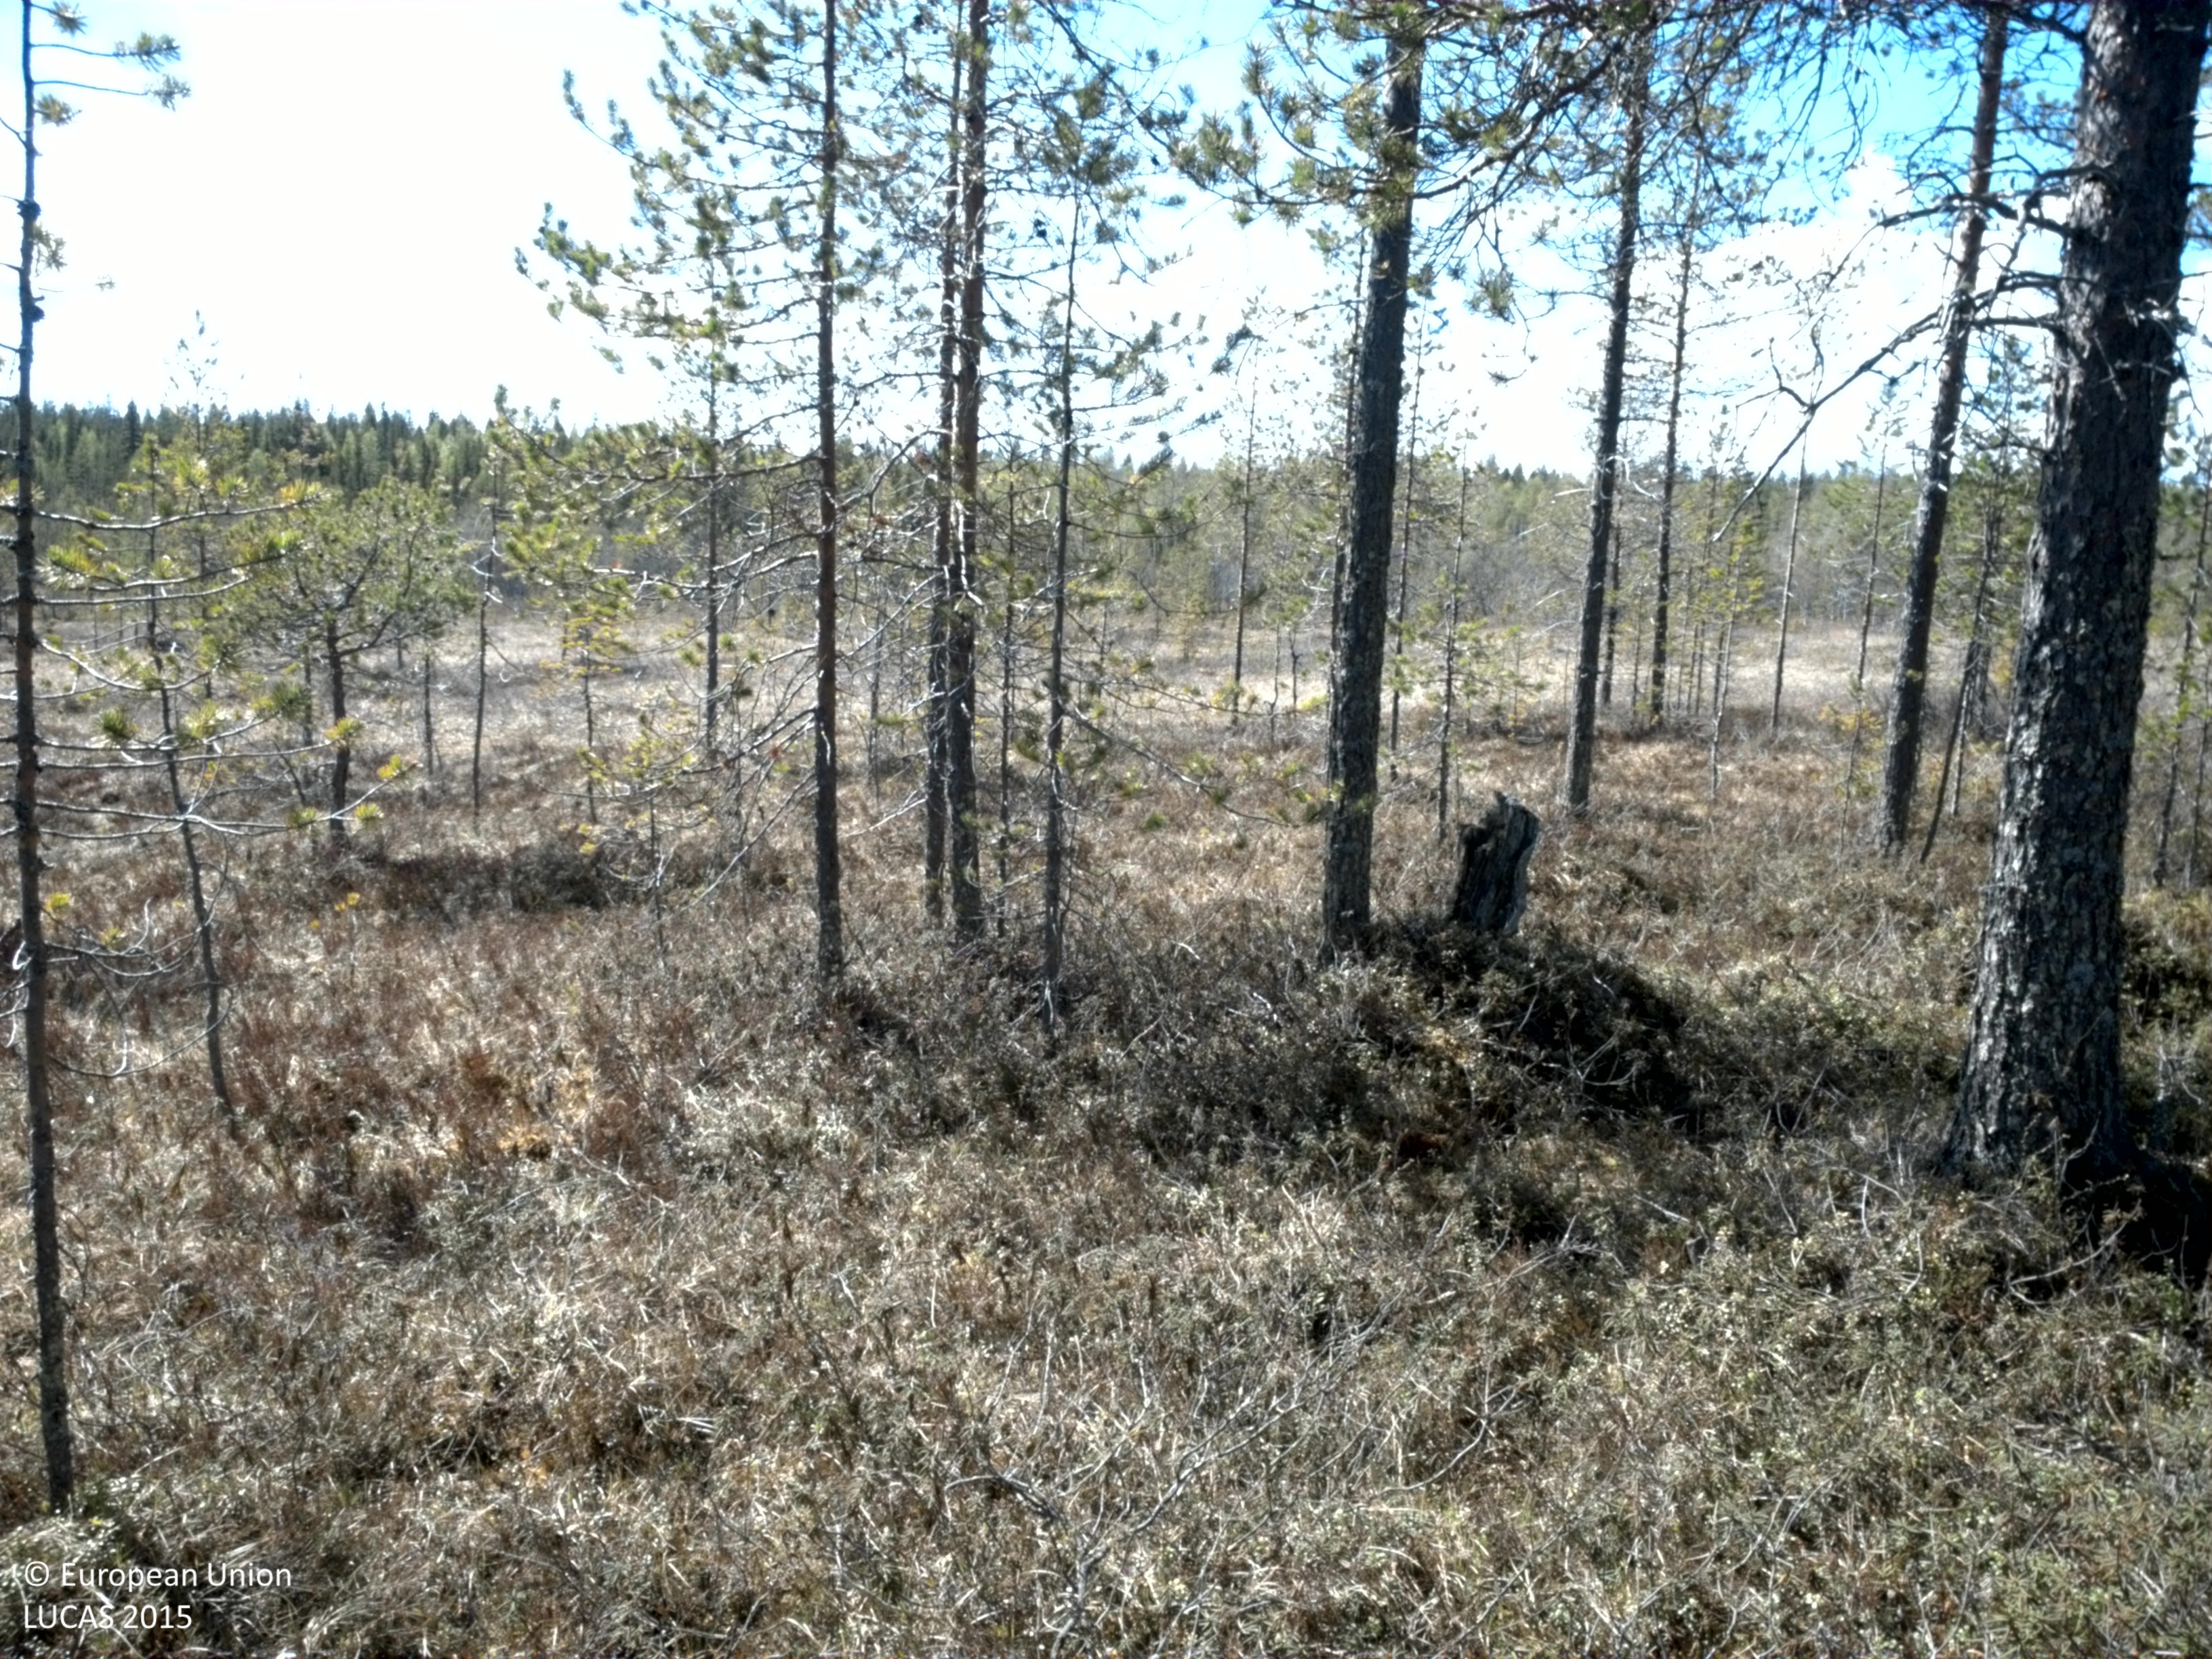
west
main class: Woodland
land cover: Pine dominated coniferous woodland
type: boreal forest
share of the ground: 25 - 50 %
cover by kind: shrubs 55 %, coniferous forest trees 45 %
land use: Forestry
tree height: > 5 m
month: May
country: SE
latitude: 66.1056
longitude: 23.1938
